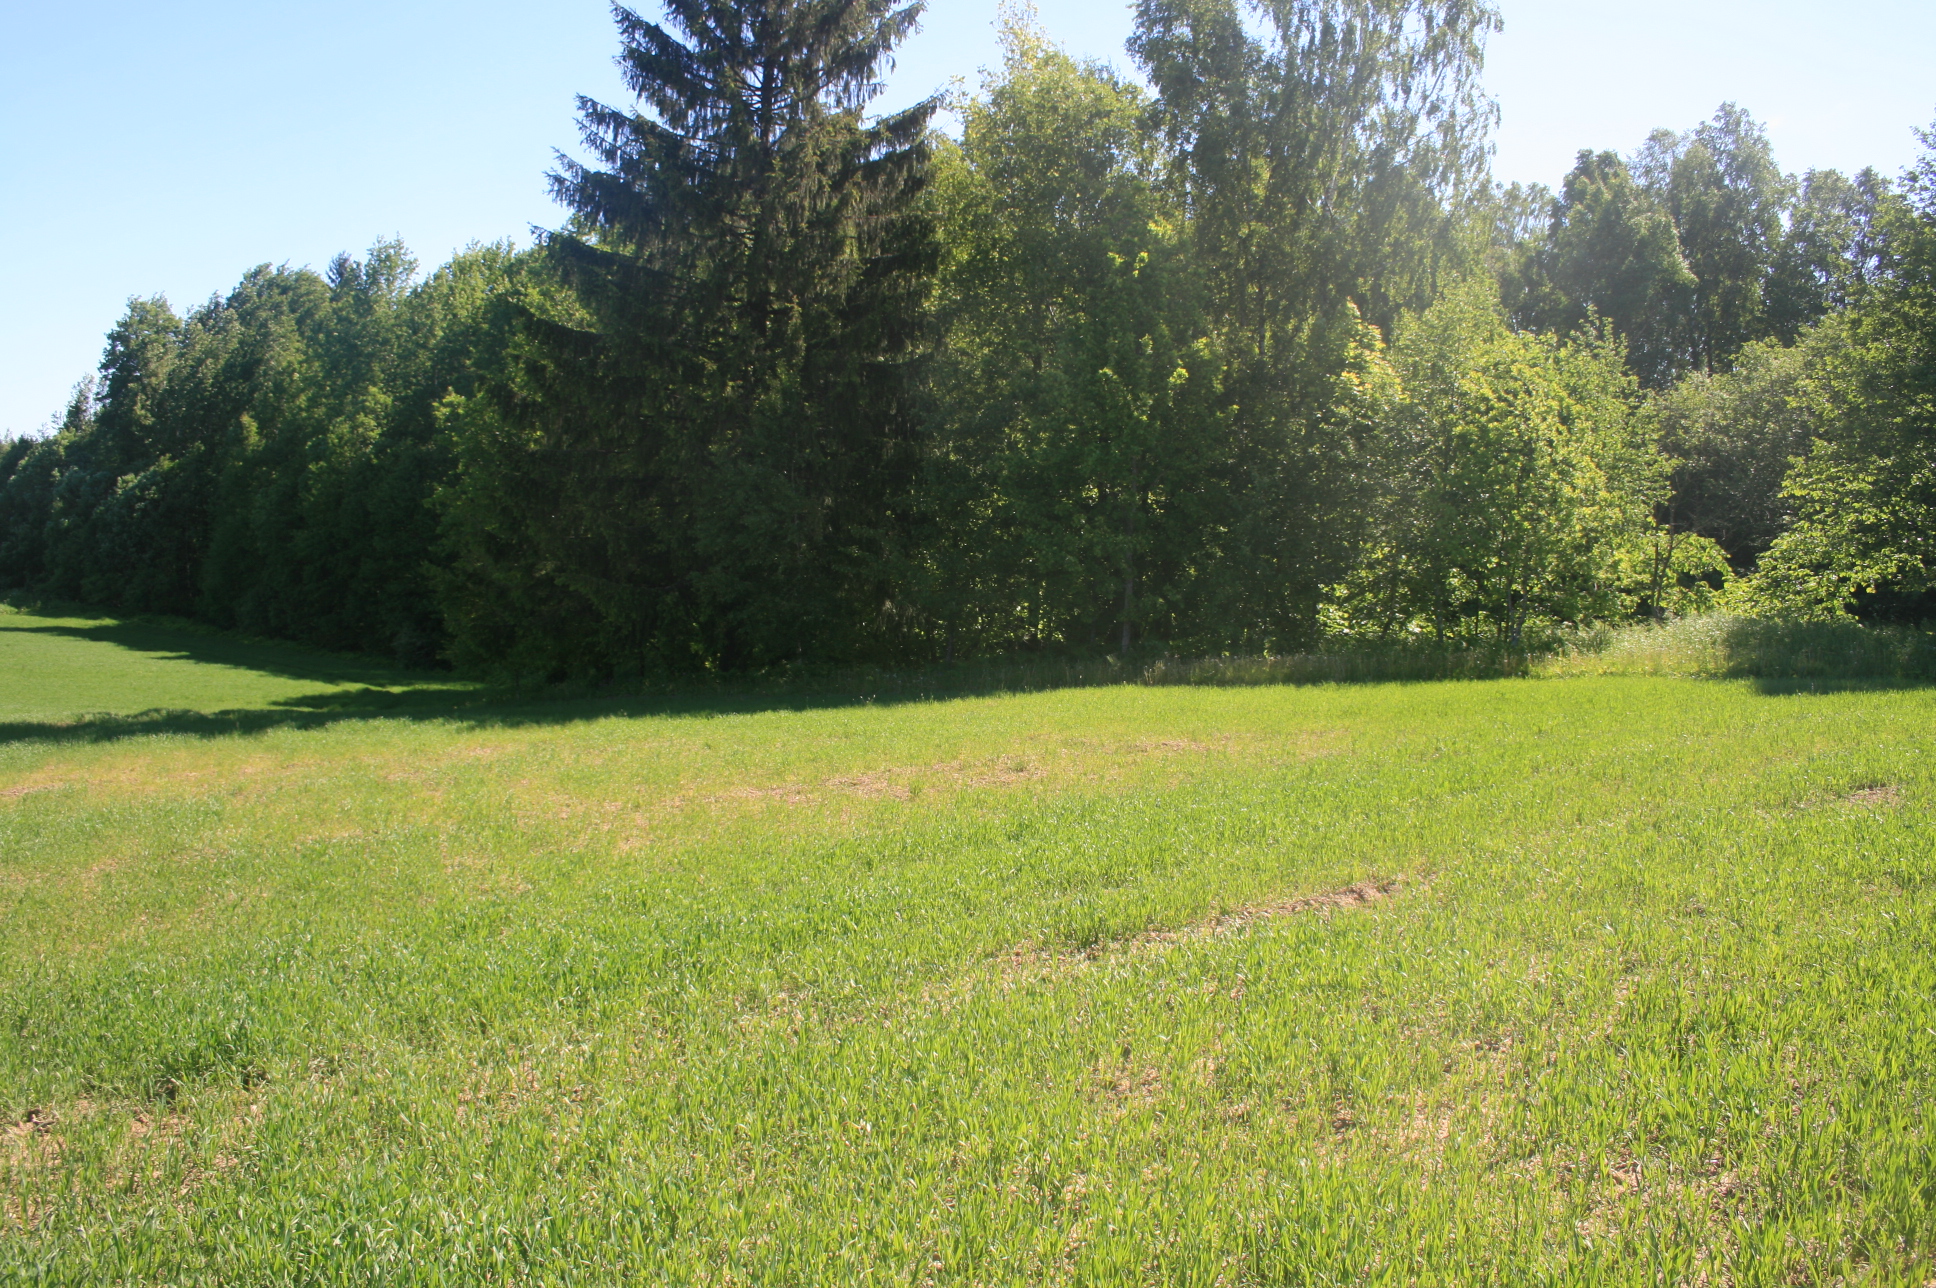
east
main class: Cropland
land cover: Common wheat
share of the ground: > 75 %
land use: Agriculture (excluding fallow land and kitchen gardens)
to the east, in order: Common wheat; Broadleaved woodland; Spontaneously vegetated surfaces; Rivers and streams; Broadleaved woodland; Shrubland with sparse tree cover; Other mixed woodland; Broadleaved woodland
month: June
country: LT
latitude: 55.9066
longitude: 22.2608
